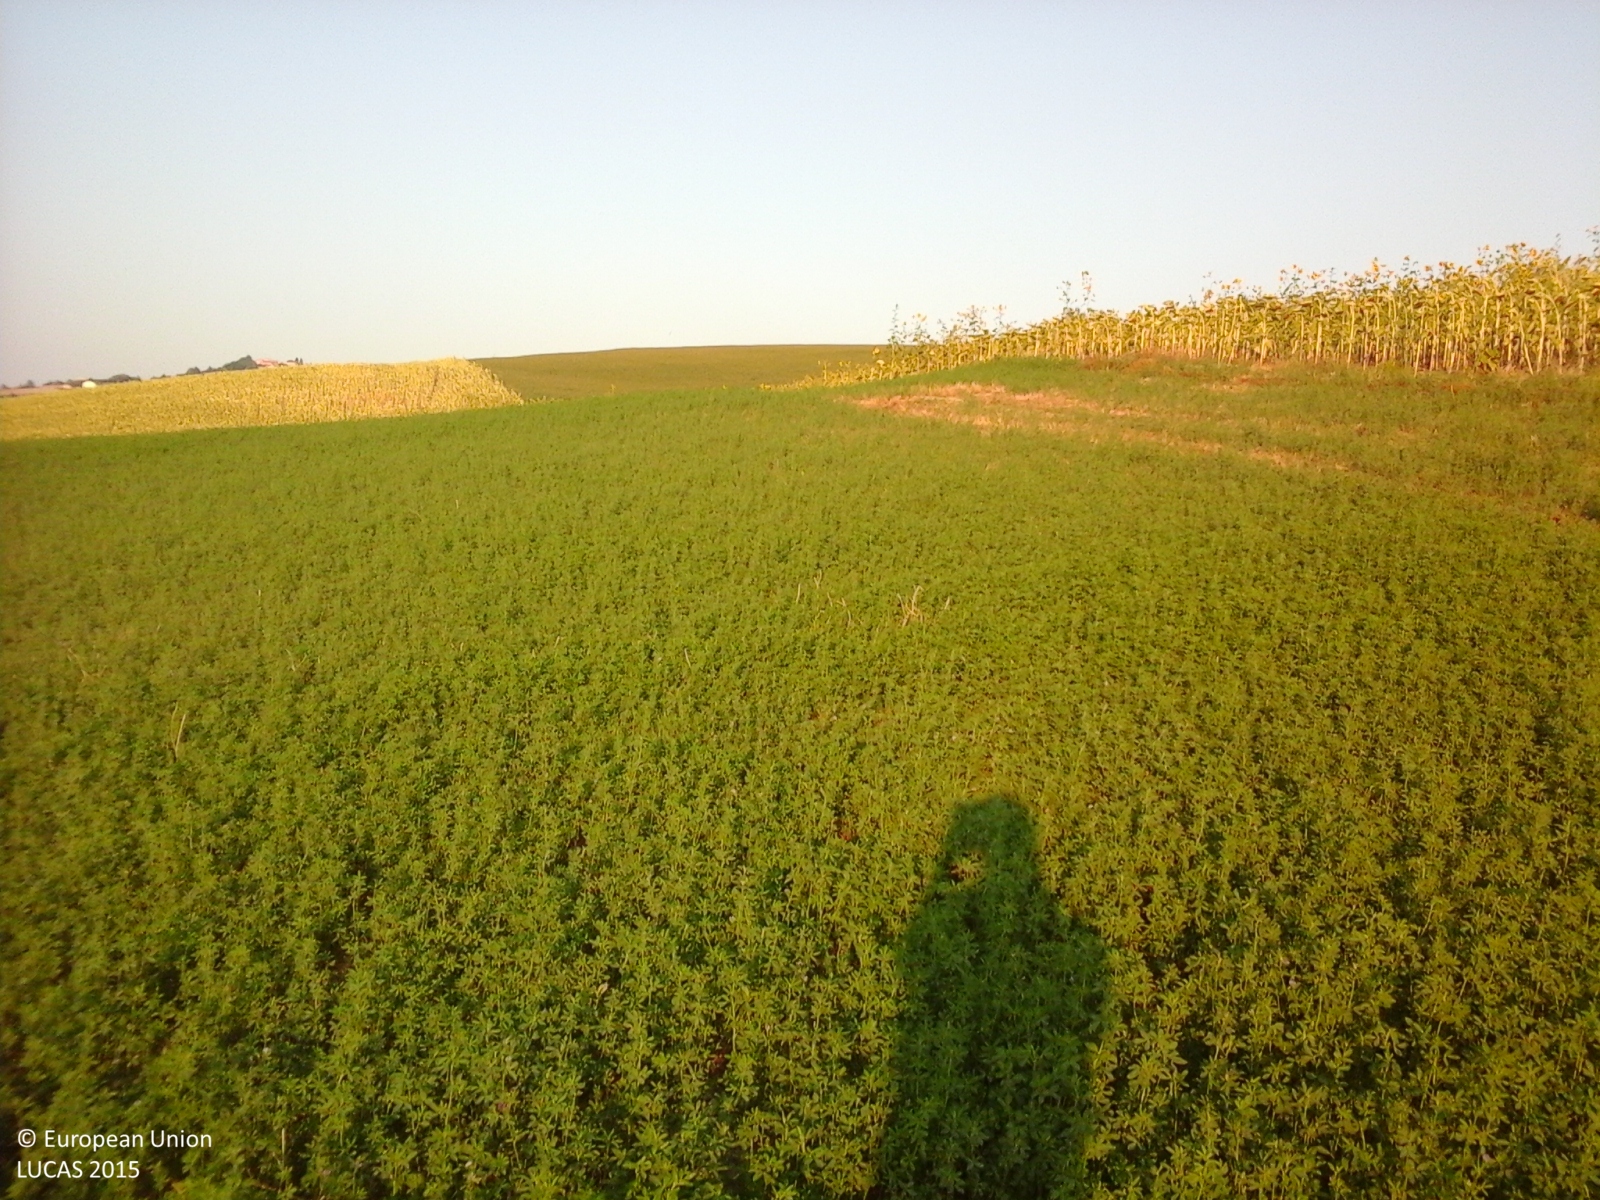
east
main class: Cropland
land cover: Lucerne
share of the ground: > 75 %
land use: Agriculture (excluding fallow land and kitchen gardens)
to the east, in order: Lucerne; Ditches and canals; Sunflower; Lucerne
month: August
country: IT
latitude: 43.1376
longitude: 13.4455
